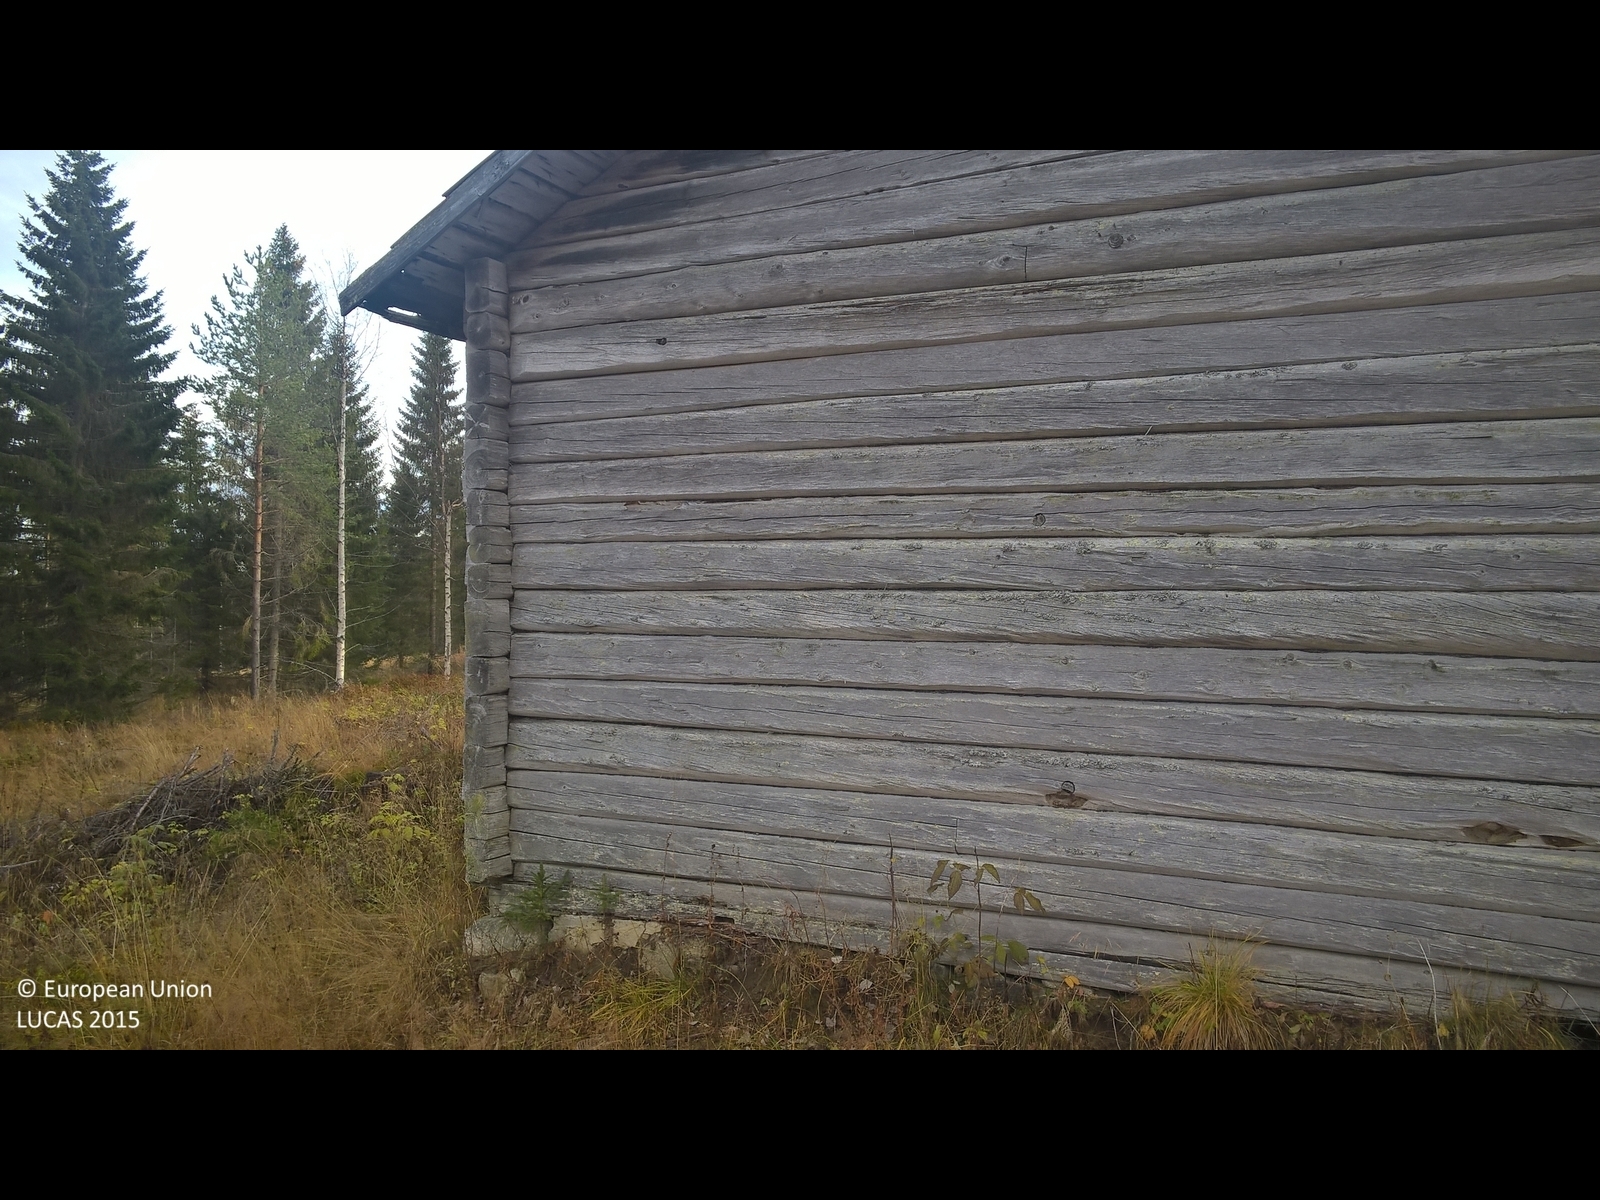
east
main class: Grassland
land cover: Spontaneously vegetated surfaces
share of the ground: > 75 %
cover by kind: herbaceous plants 100 %
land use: Forestry
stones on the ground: < 10 %
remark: Clear cut
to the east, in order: Spontaneously vegetated surfaces; Artificial constructions in urban areas; Spontaneously vegetated surfaces; Spruce dominated mixed woodland; Spontaneously vegetated surfaces; Spruce dominated mixed woodland
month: October
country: SE
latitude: 63.2325
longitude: 15.0524
